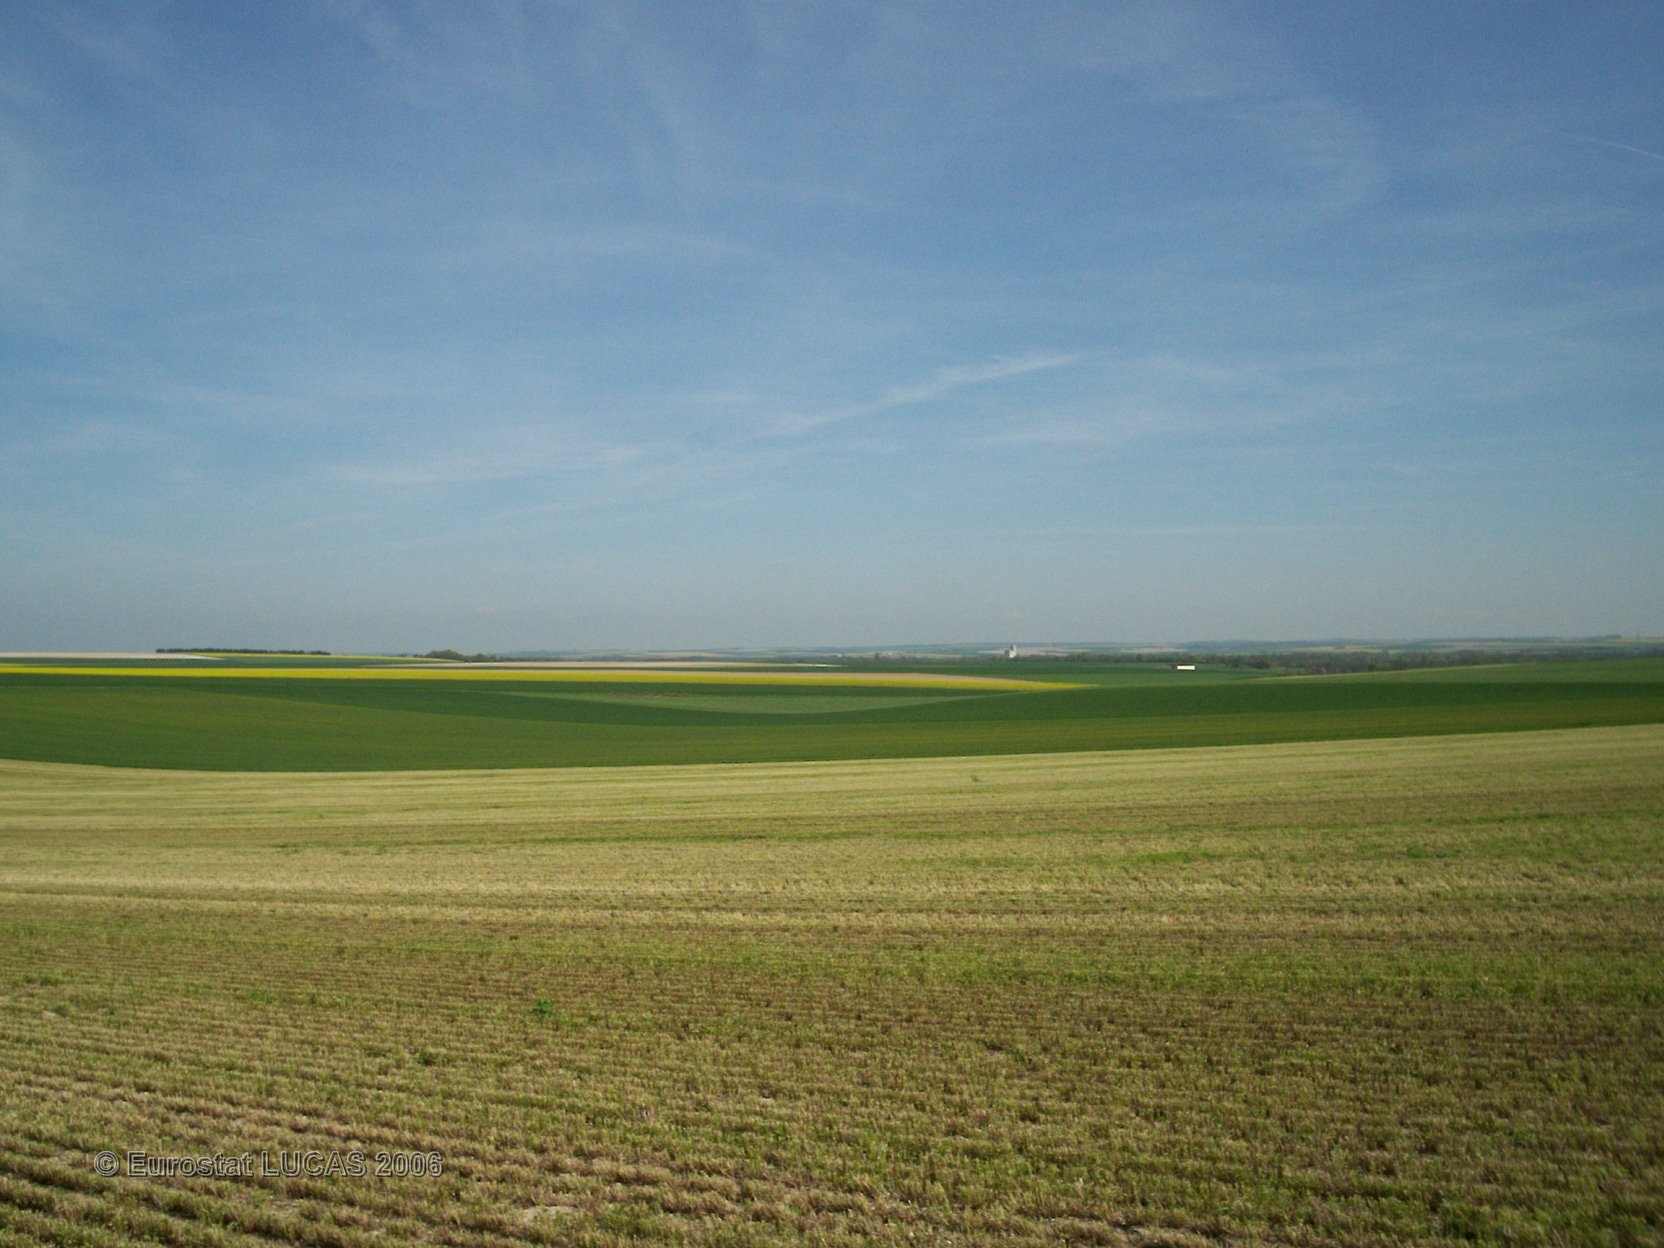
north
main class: Cropland
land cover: Lucerne
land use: Agriculture (excluding fallow land and kitchen gardens)
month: May
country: FR
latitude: 48.8399
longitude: 4.4239
